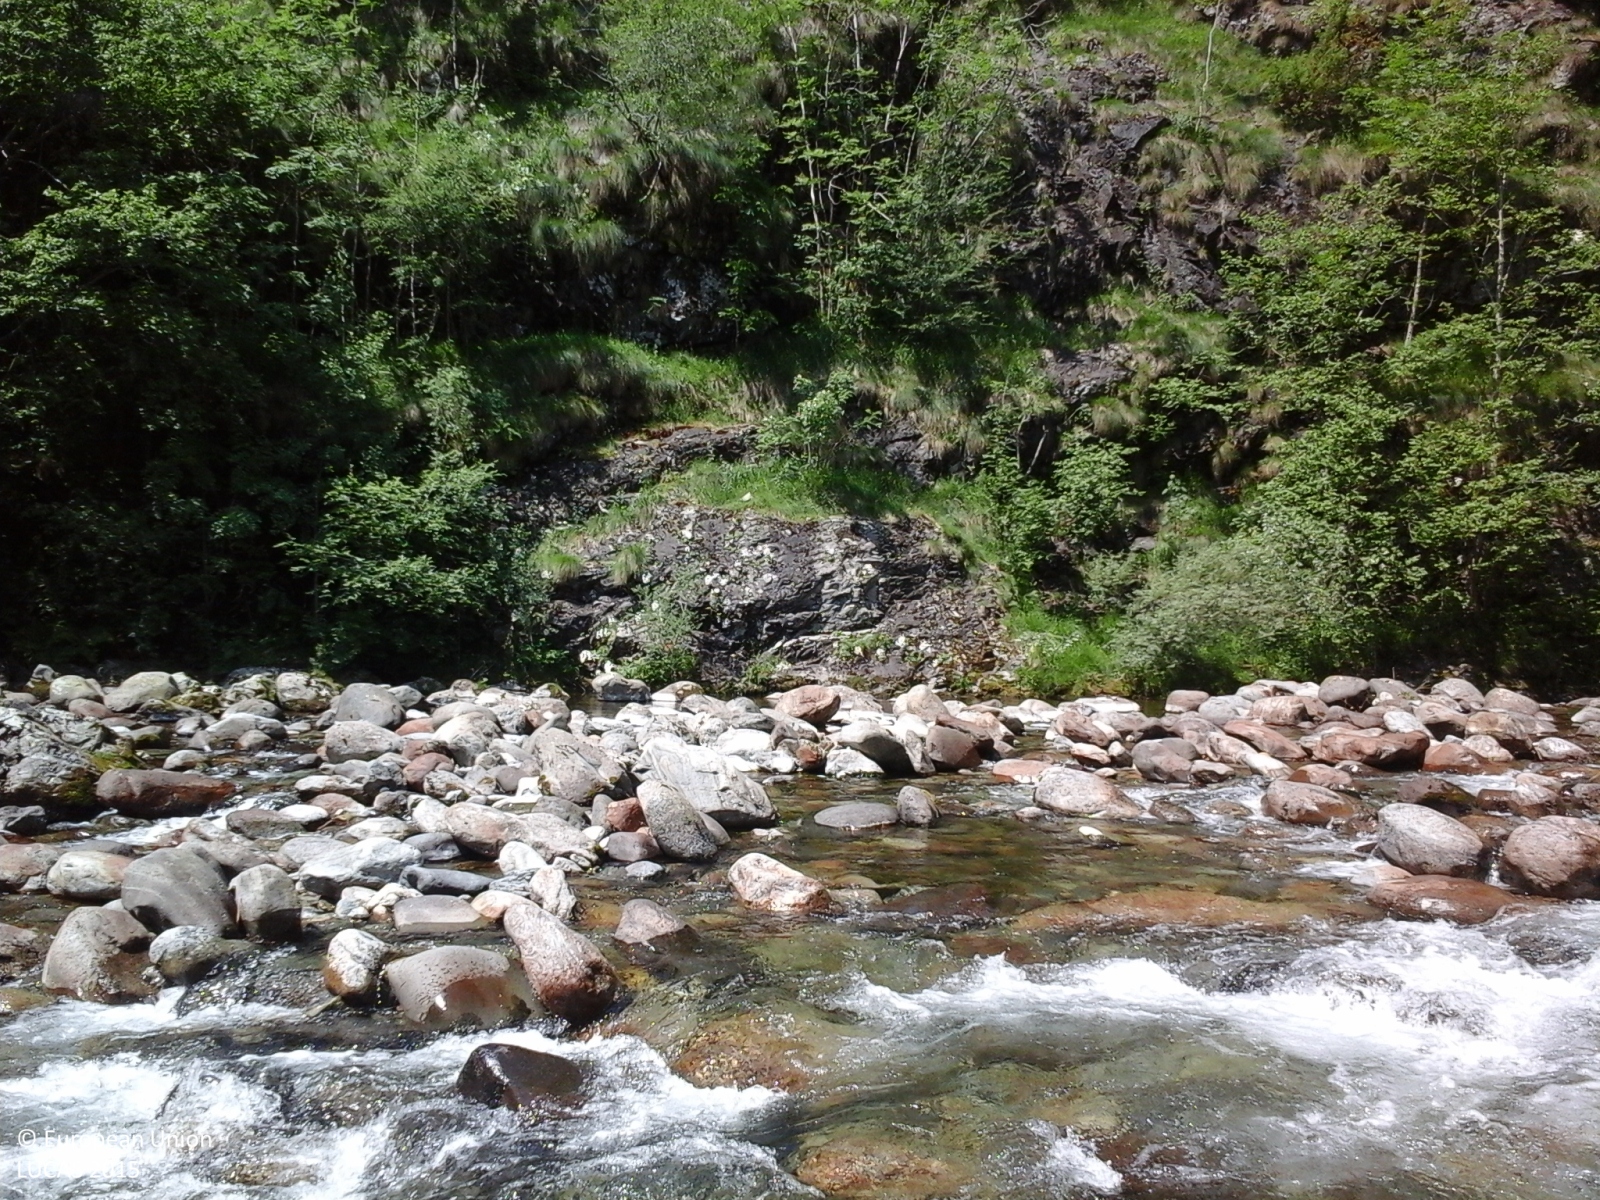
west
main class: Woodland
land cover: Broadleaved woodland
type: mesophytic deciduous forest
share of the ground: > 75 %
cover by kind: broadleaved forest trees 100 %
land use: Forestry
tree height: > 5 m
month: June
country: IT
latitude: 45.8673
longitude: 8.1863
